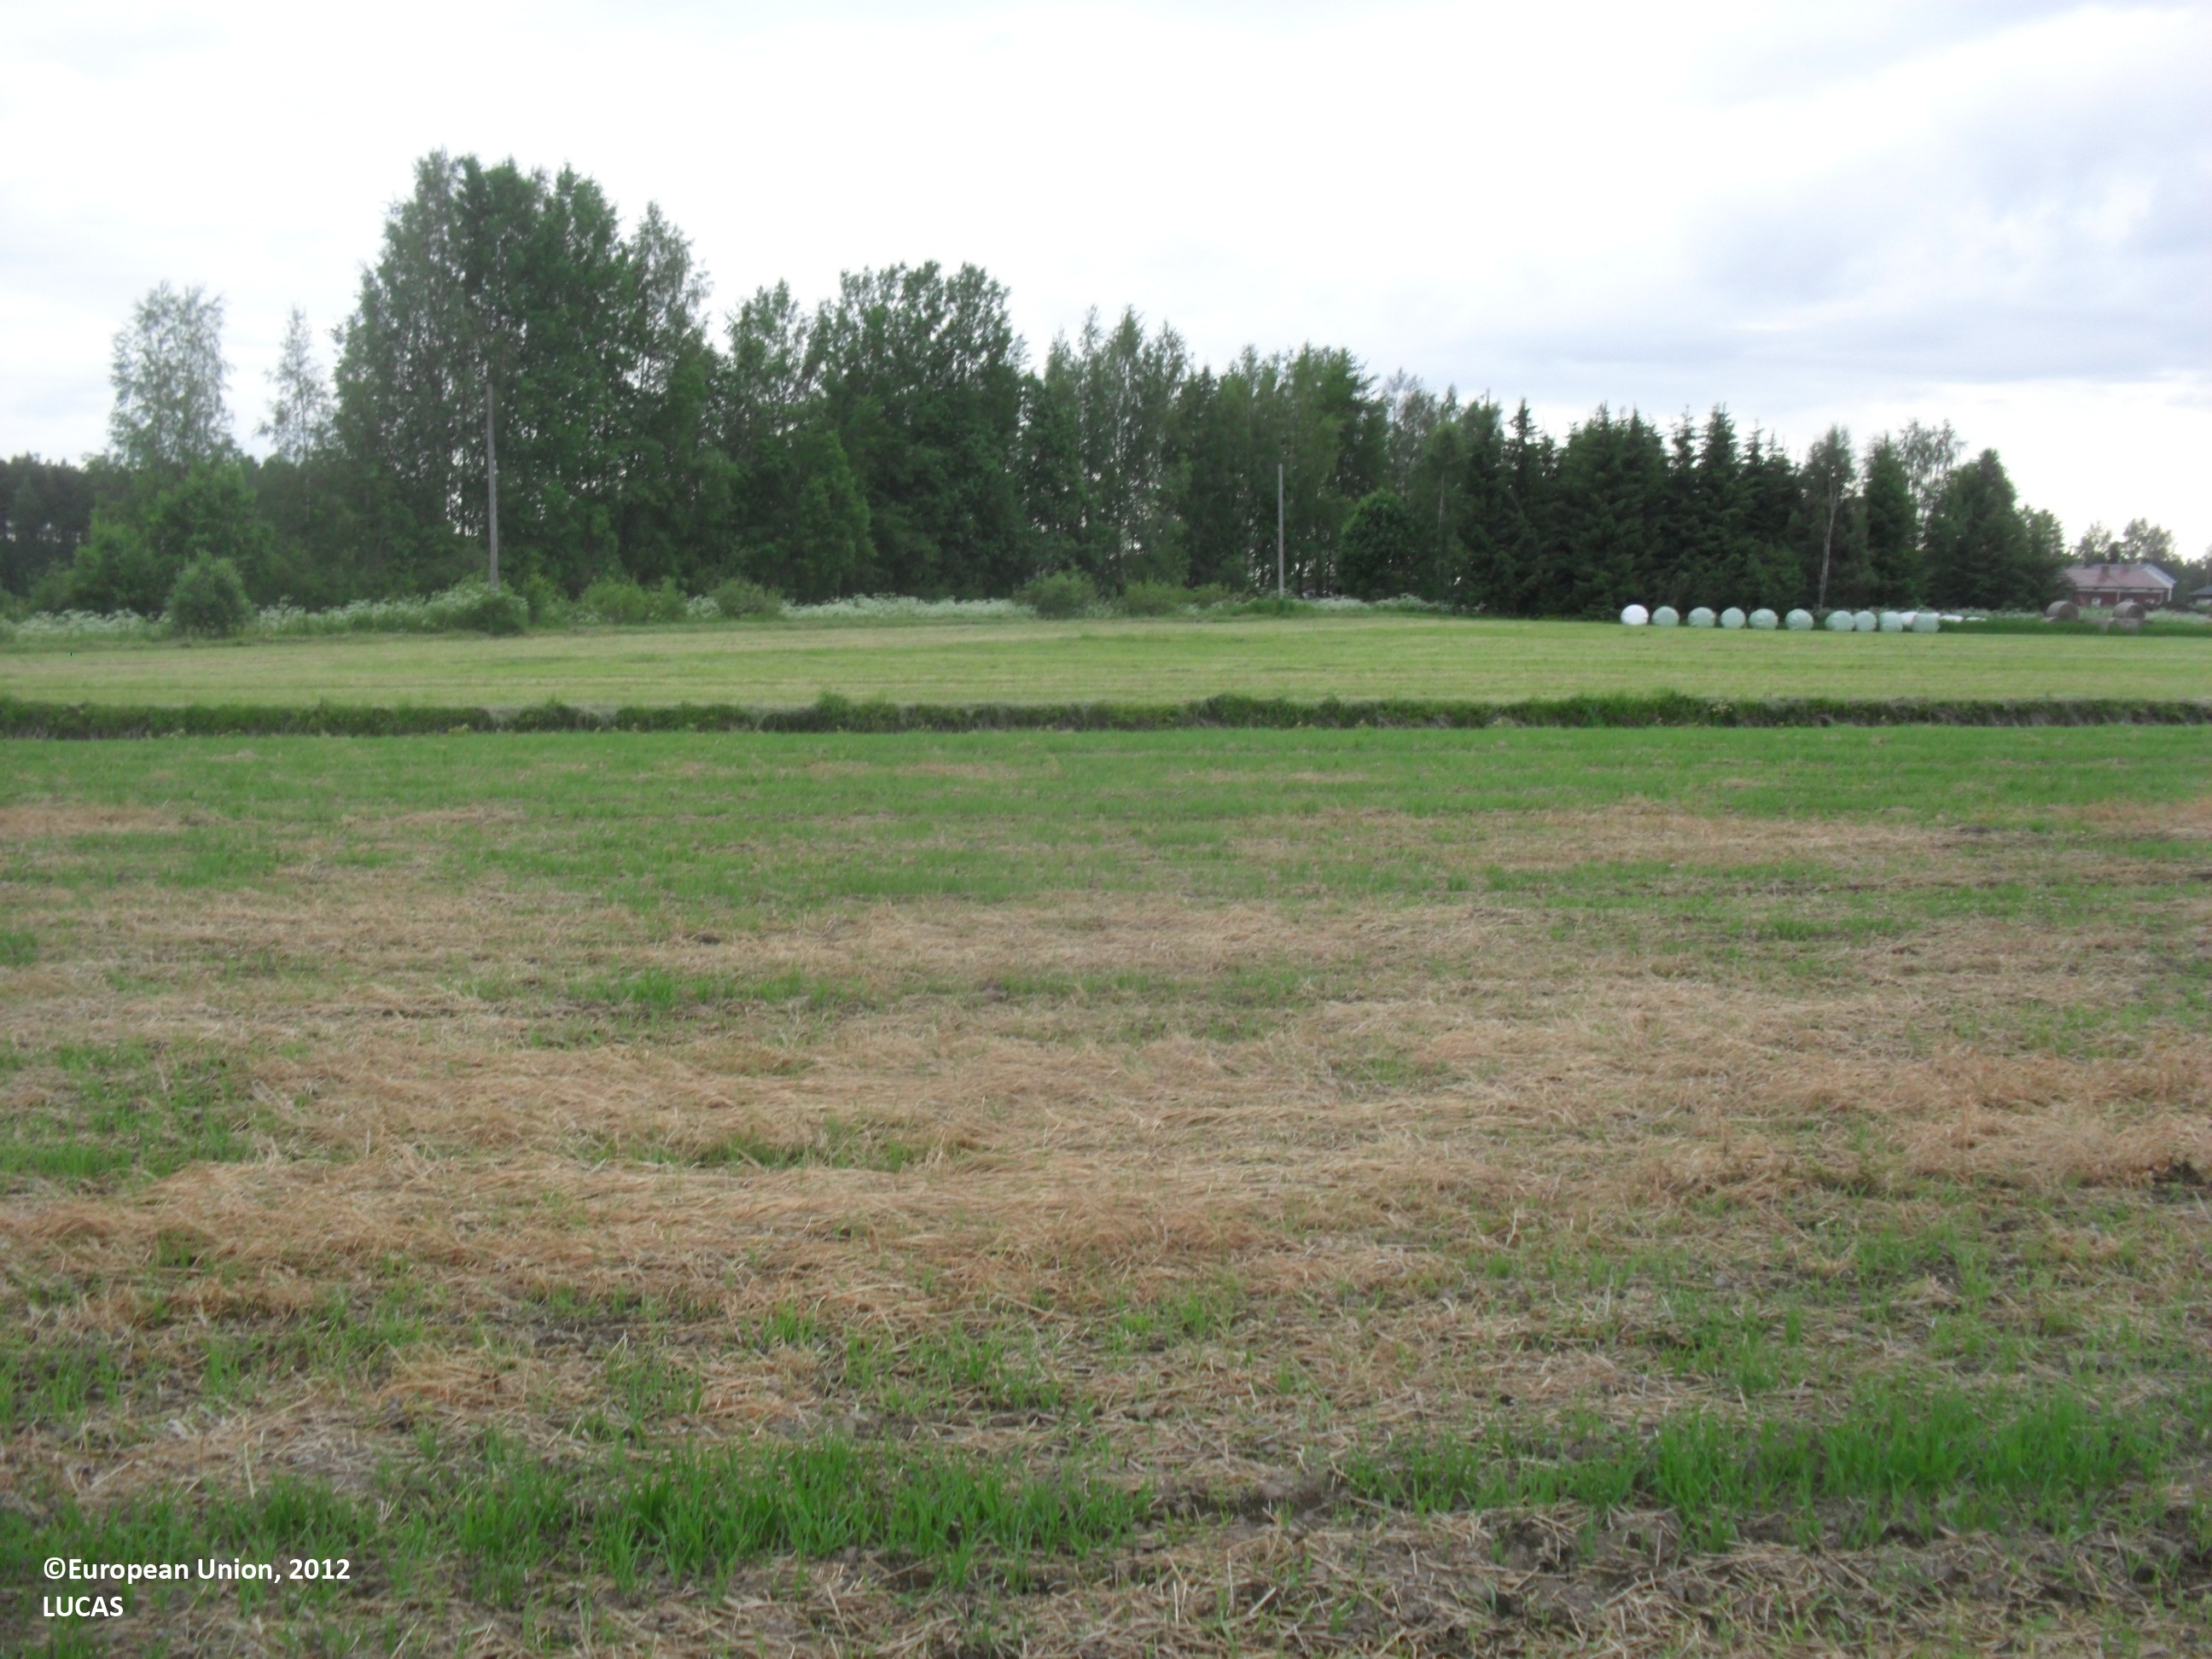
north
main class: Cropland
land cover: Barley
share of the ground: < 10 %
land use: Agriculture (excluding fallow land and kitchen gardens)
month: June
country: FI
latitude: 63.3216
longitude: 23.2962
